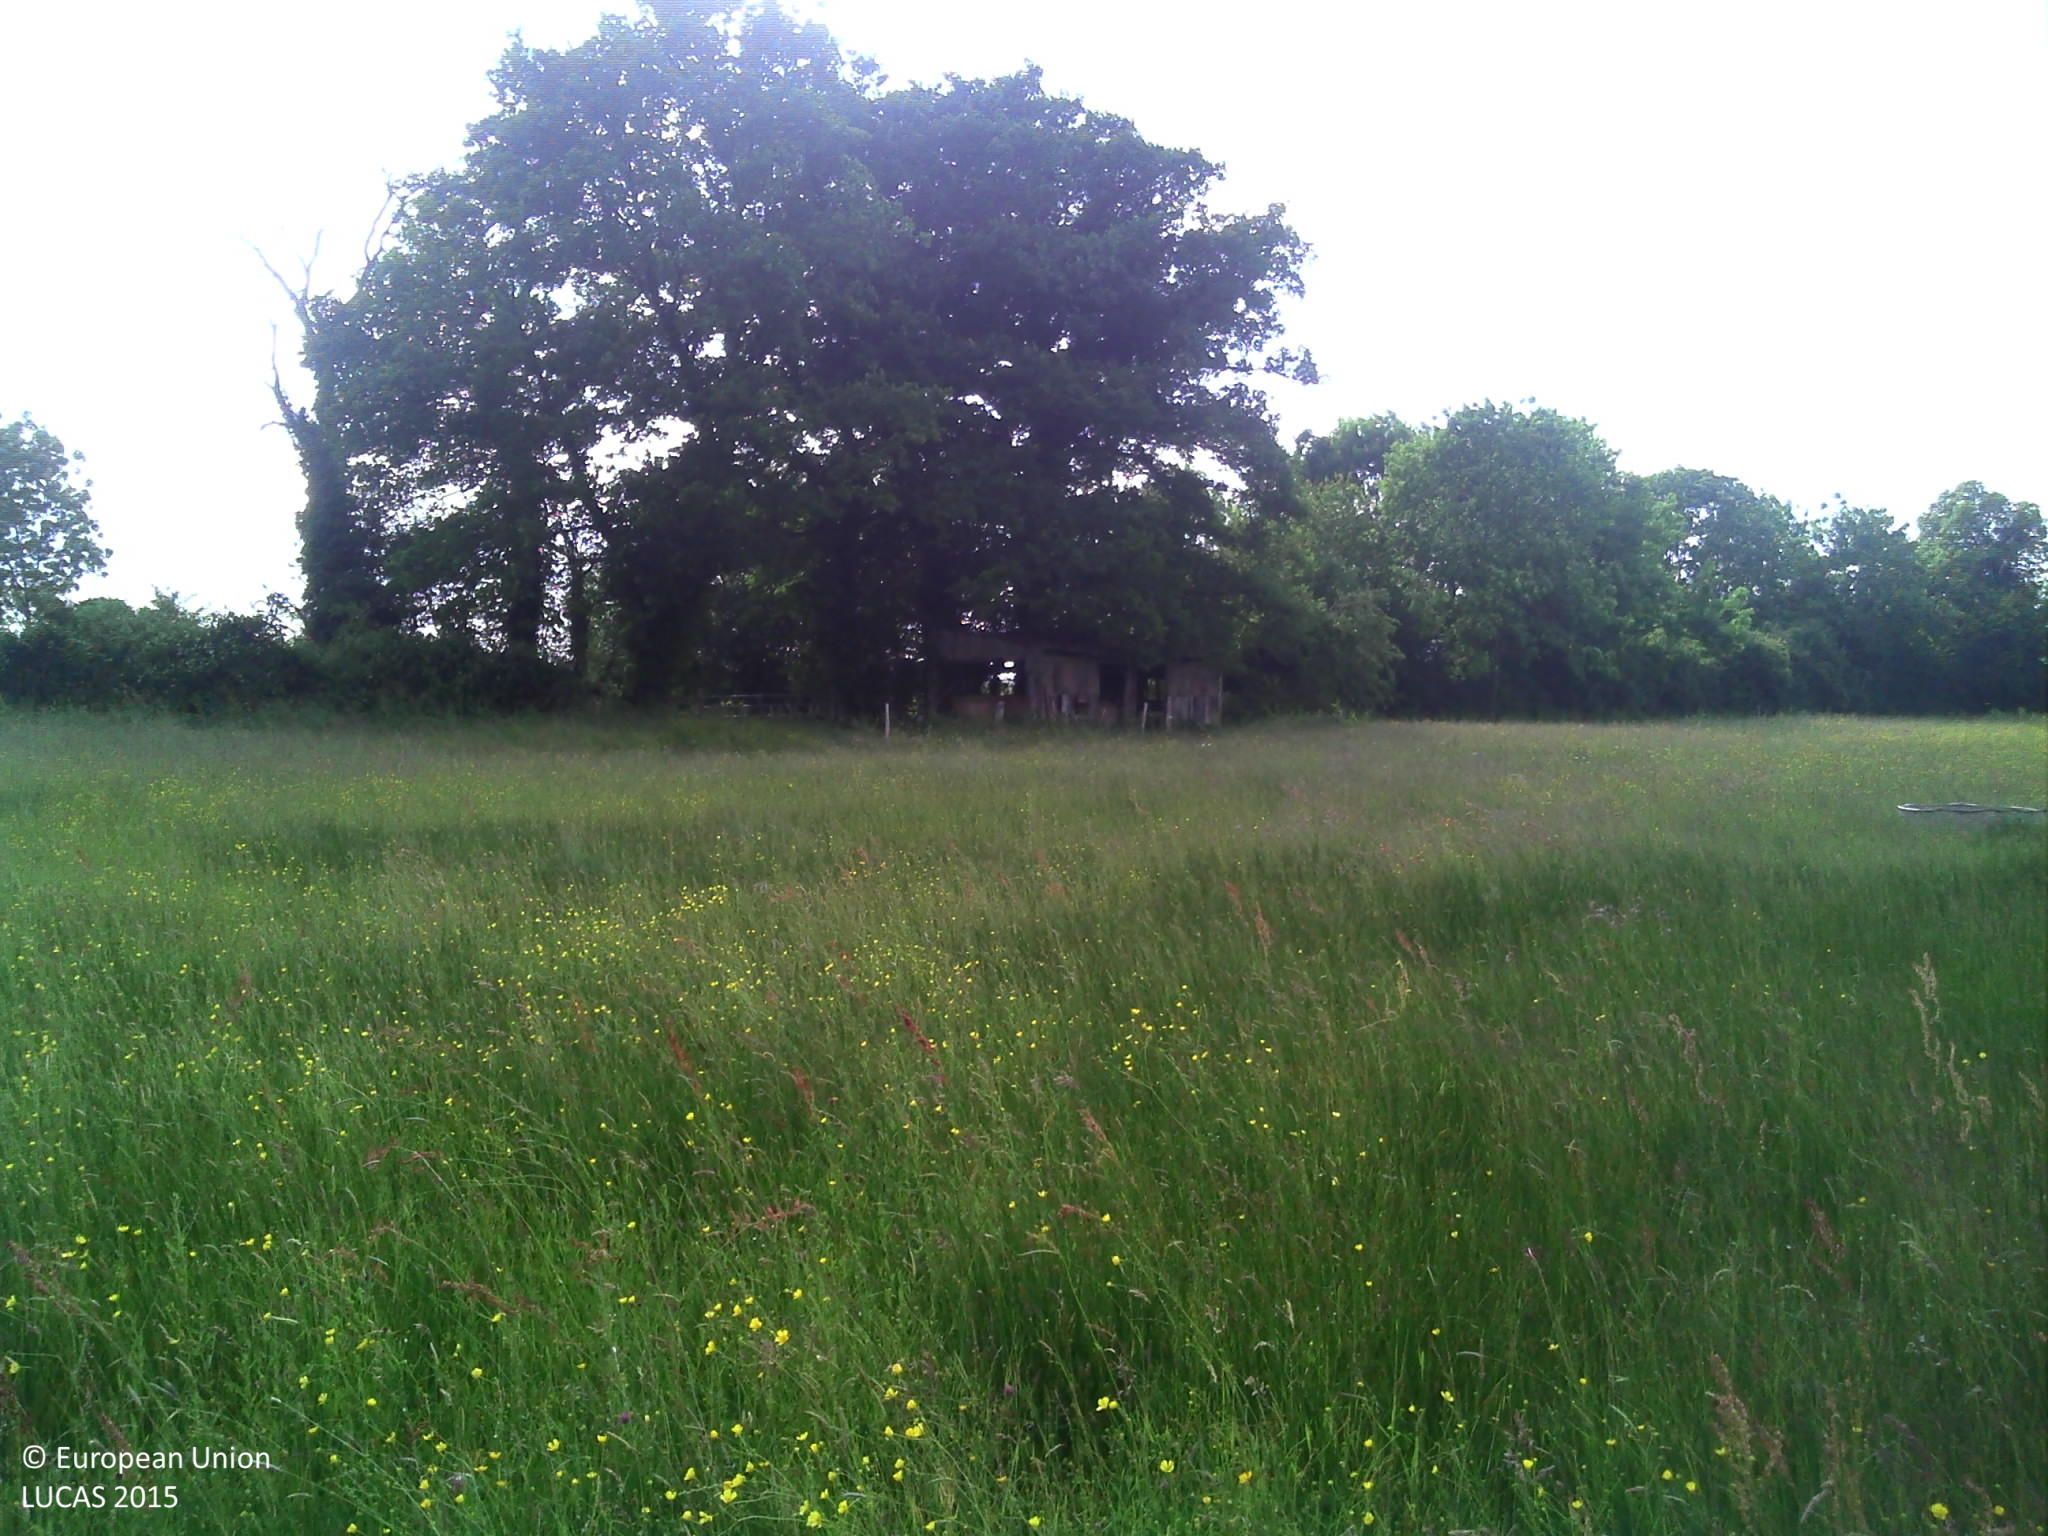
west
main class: Grassland
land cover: Grassland without tree/shrub cover
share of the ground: > 75 %
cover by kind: herbaceous plants 95 %
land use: Agriculture (excluding fallow land and kitchen gardens)
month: June
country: FR
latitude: 48.6448
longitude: 0.0765
